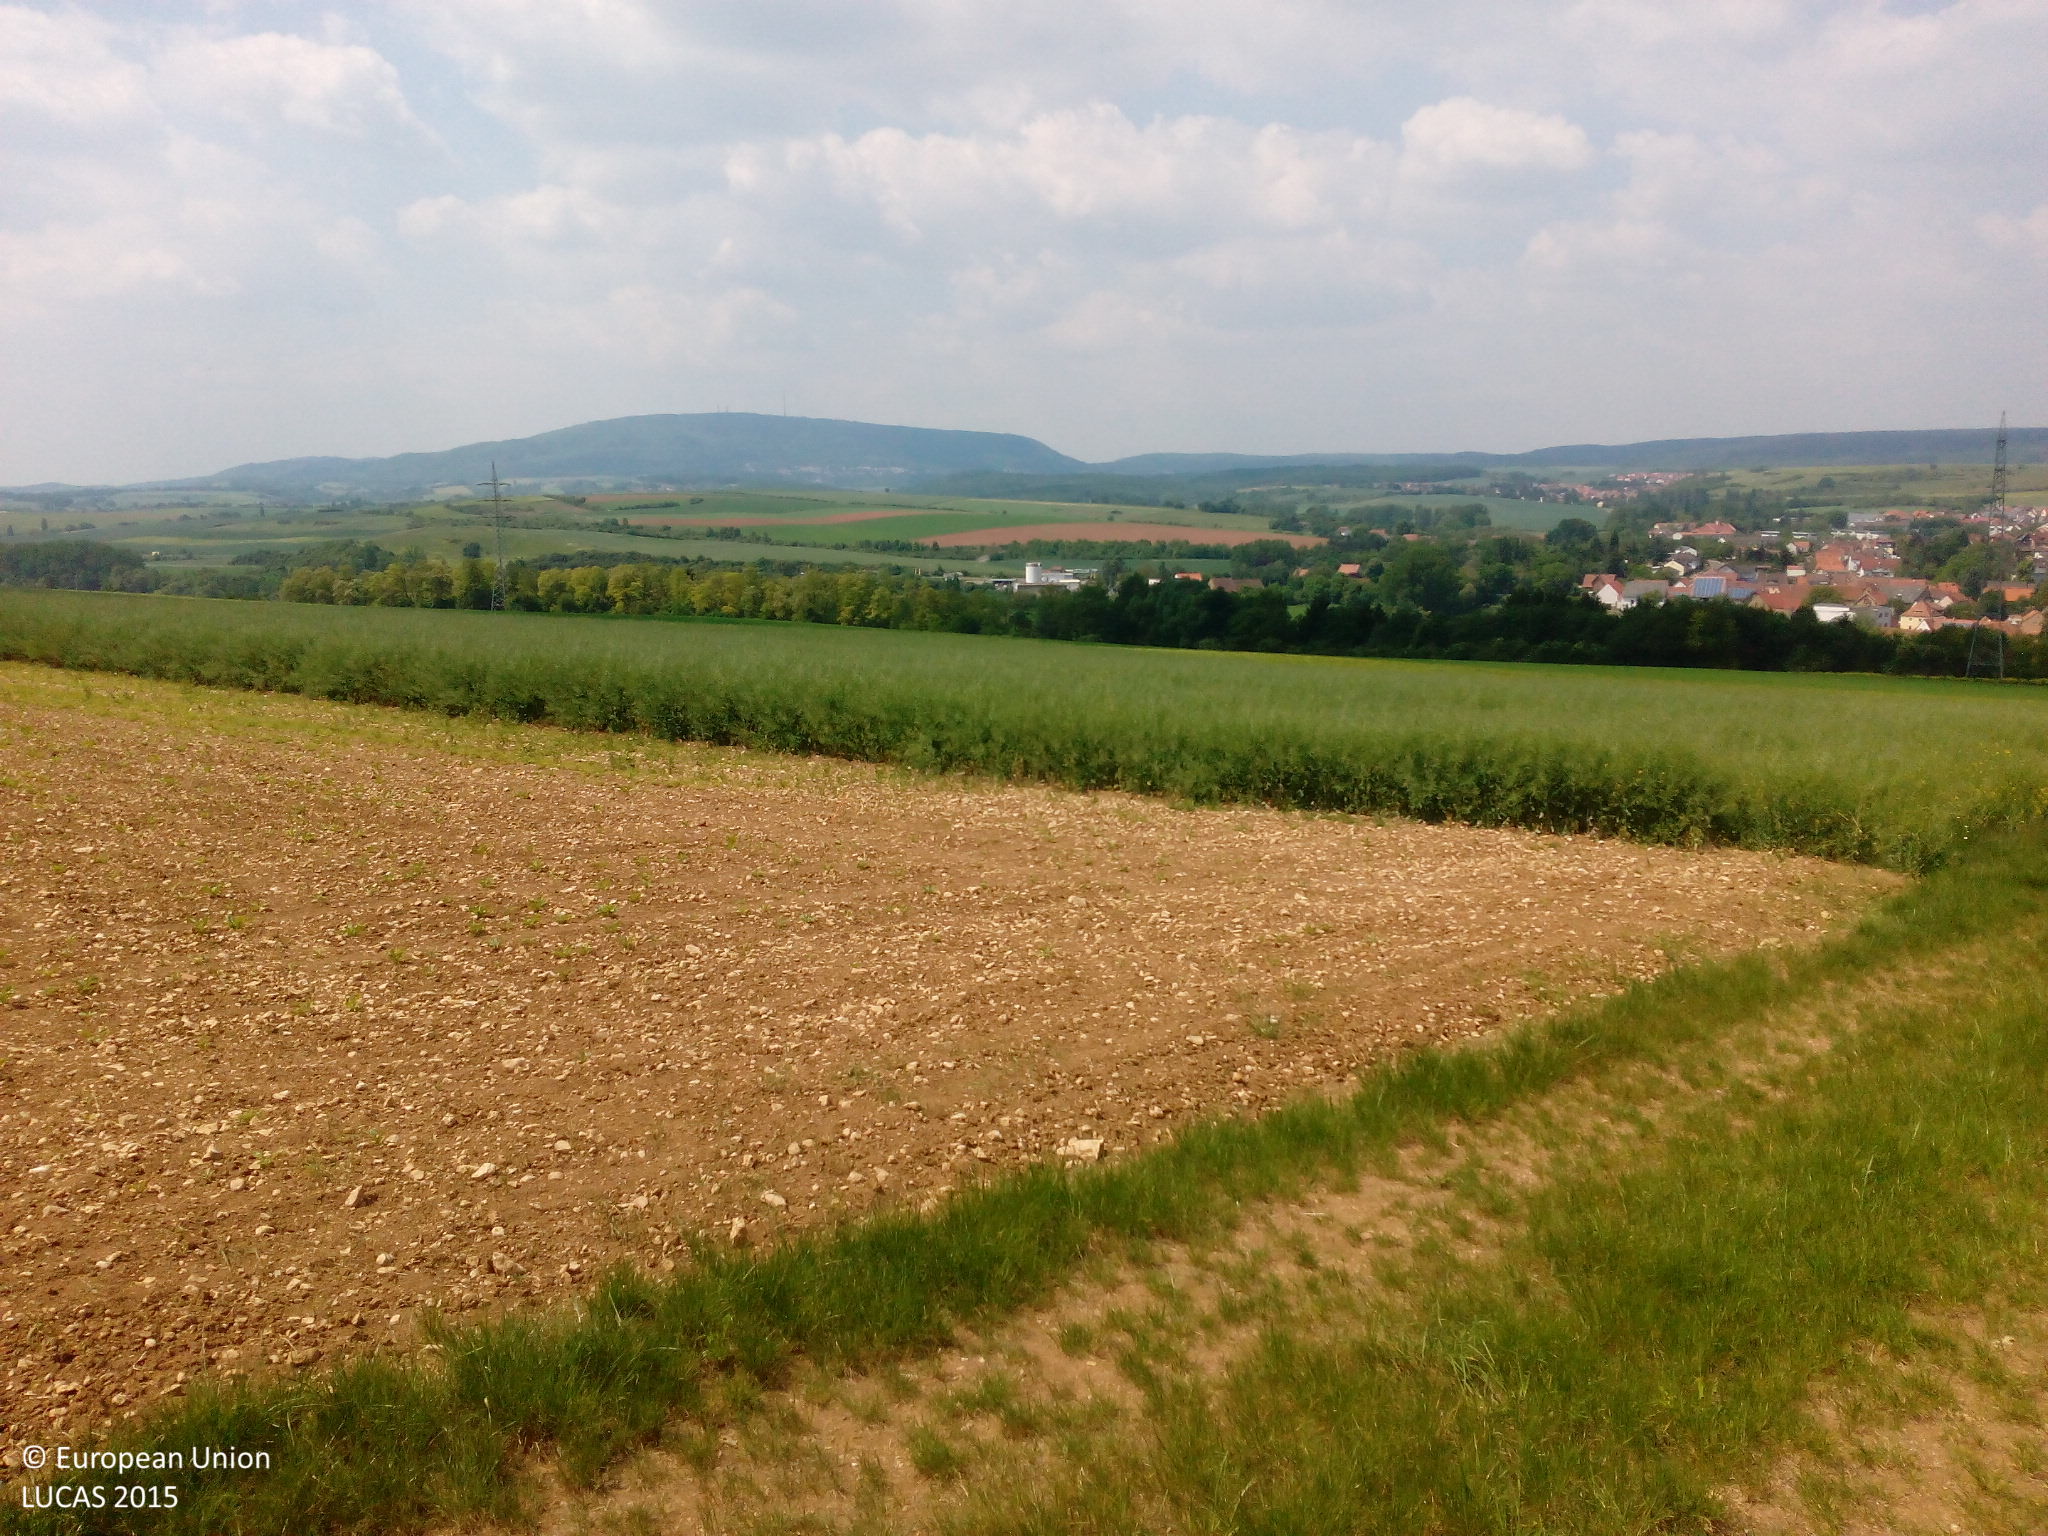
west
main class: Cropland
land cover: Other leguminous and mixtures for fodder
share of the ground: 50 - 75 %
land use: Agriculture (excluding fallow land and kitchen gardens)
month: May
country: DE
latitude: 49.6279
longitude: 8.0484
